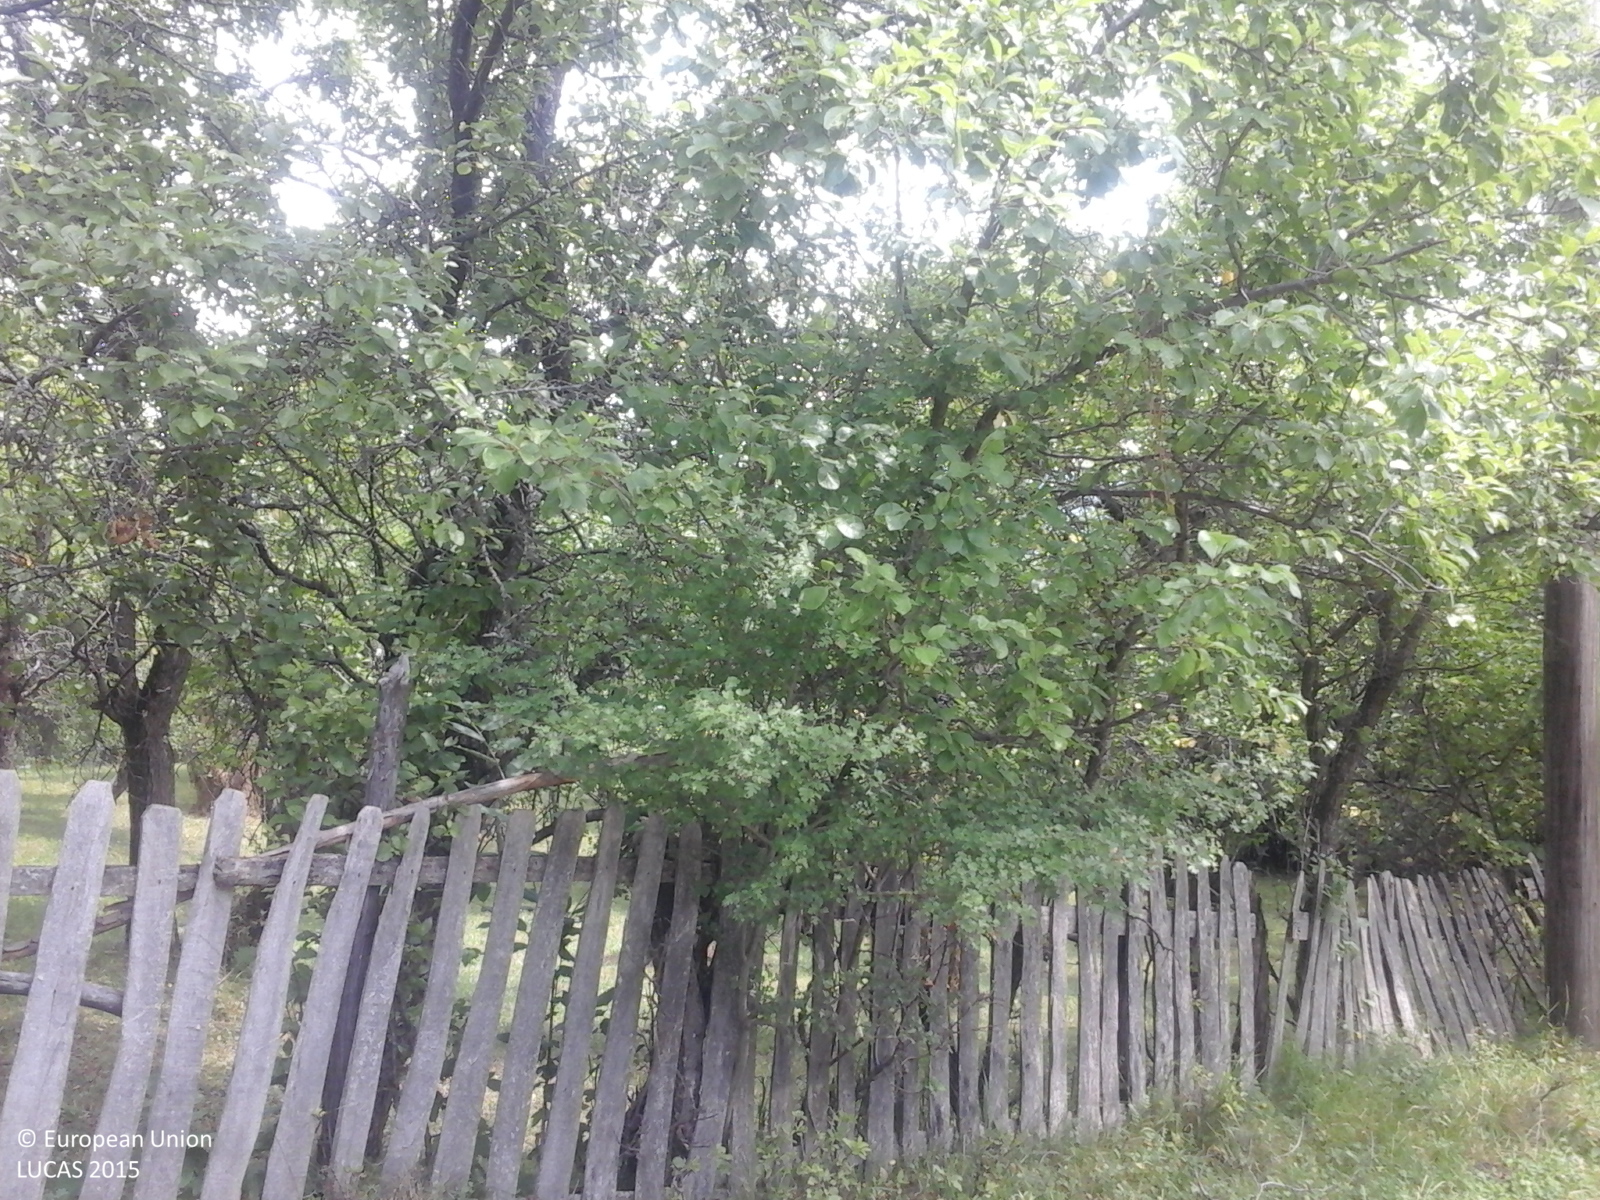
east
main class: Cropland
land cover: Other fruit trees and berries
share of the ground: 50 - 75 %
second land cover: Grassland without tree/shrub cover
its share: 50 - 75 %
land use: Agriculture (excluding fallow land and kitchen gardens)
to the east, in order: Other fruit trees and berries; Grassland without tree/shrub cover; Permanent crops (only in case pi); Abandoned hedges; Permanent crops (only in case pi); Fences; Permanent crops (only in case pi); Other fruit trees and berries
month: July
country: RO
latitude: 45.3369
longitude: 24.7714
